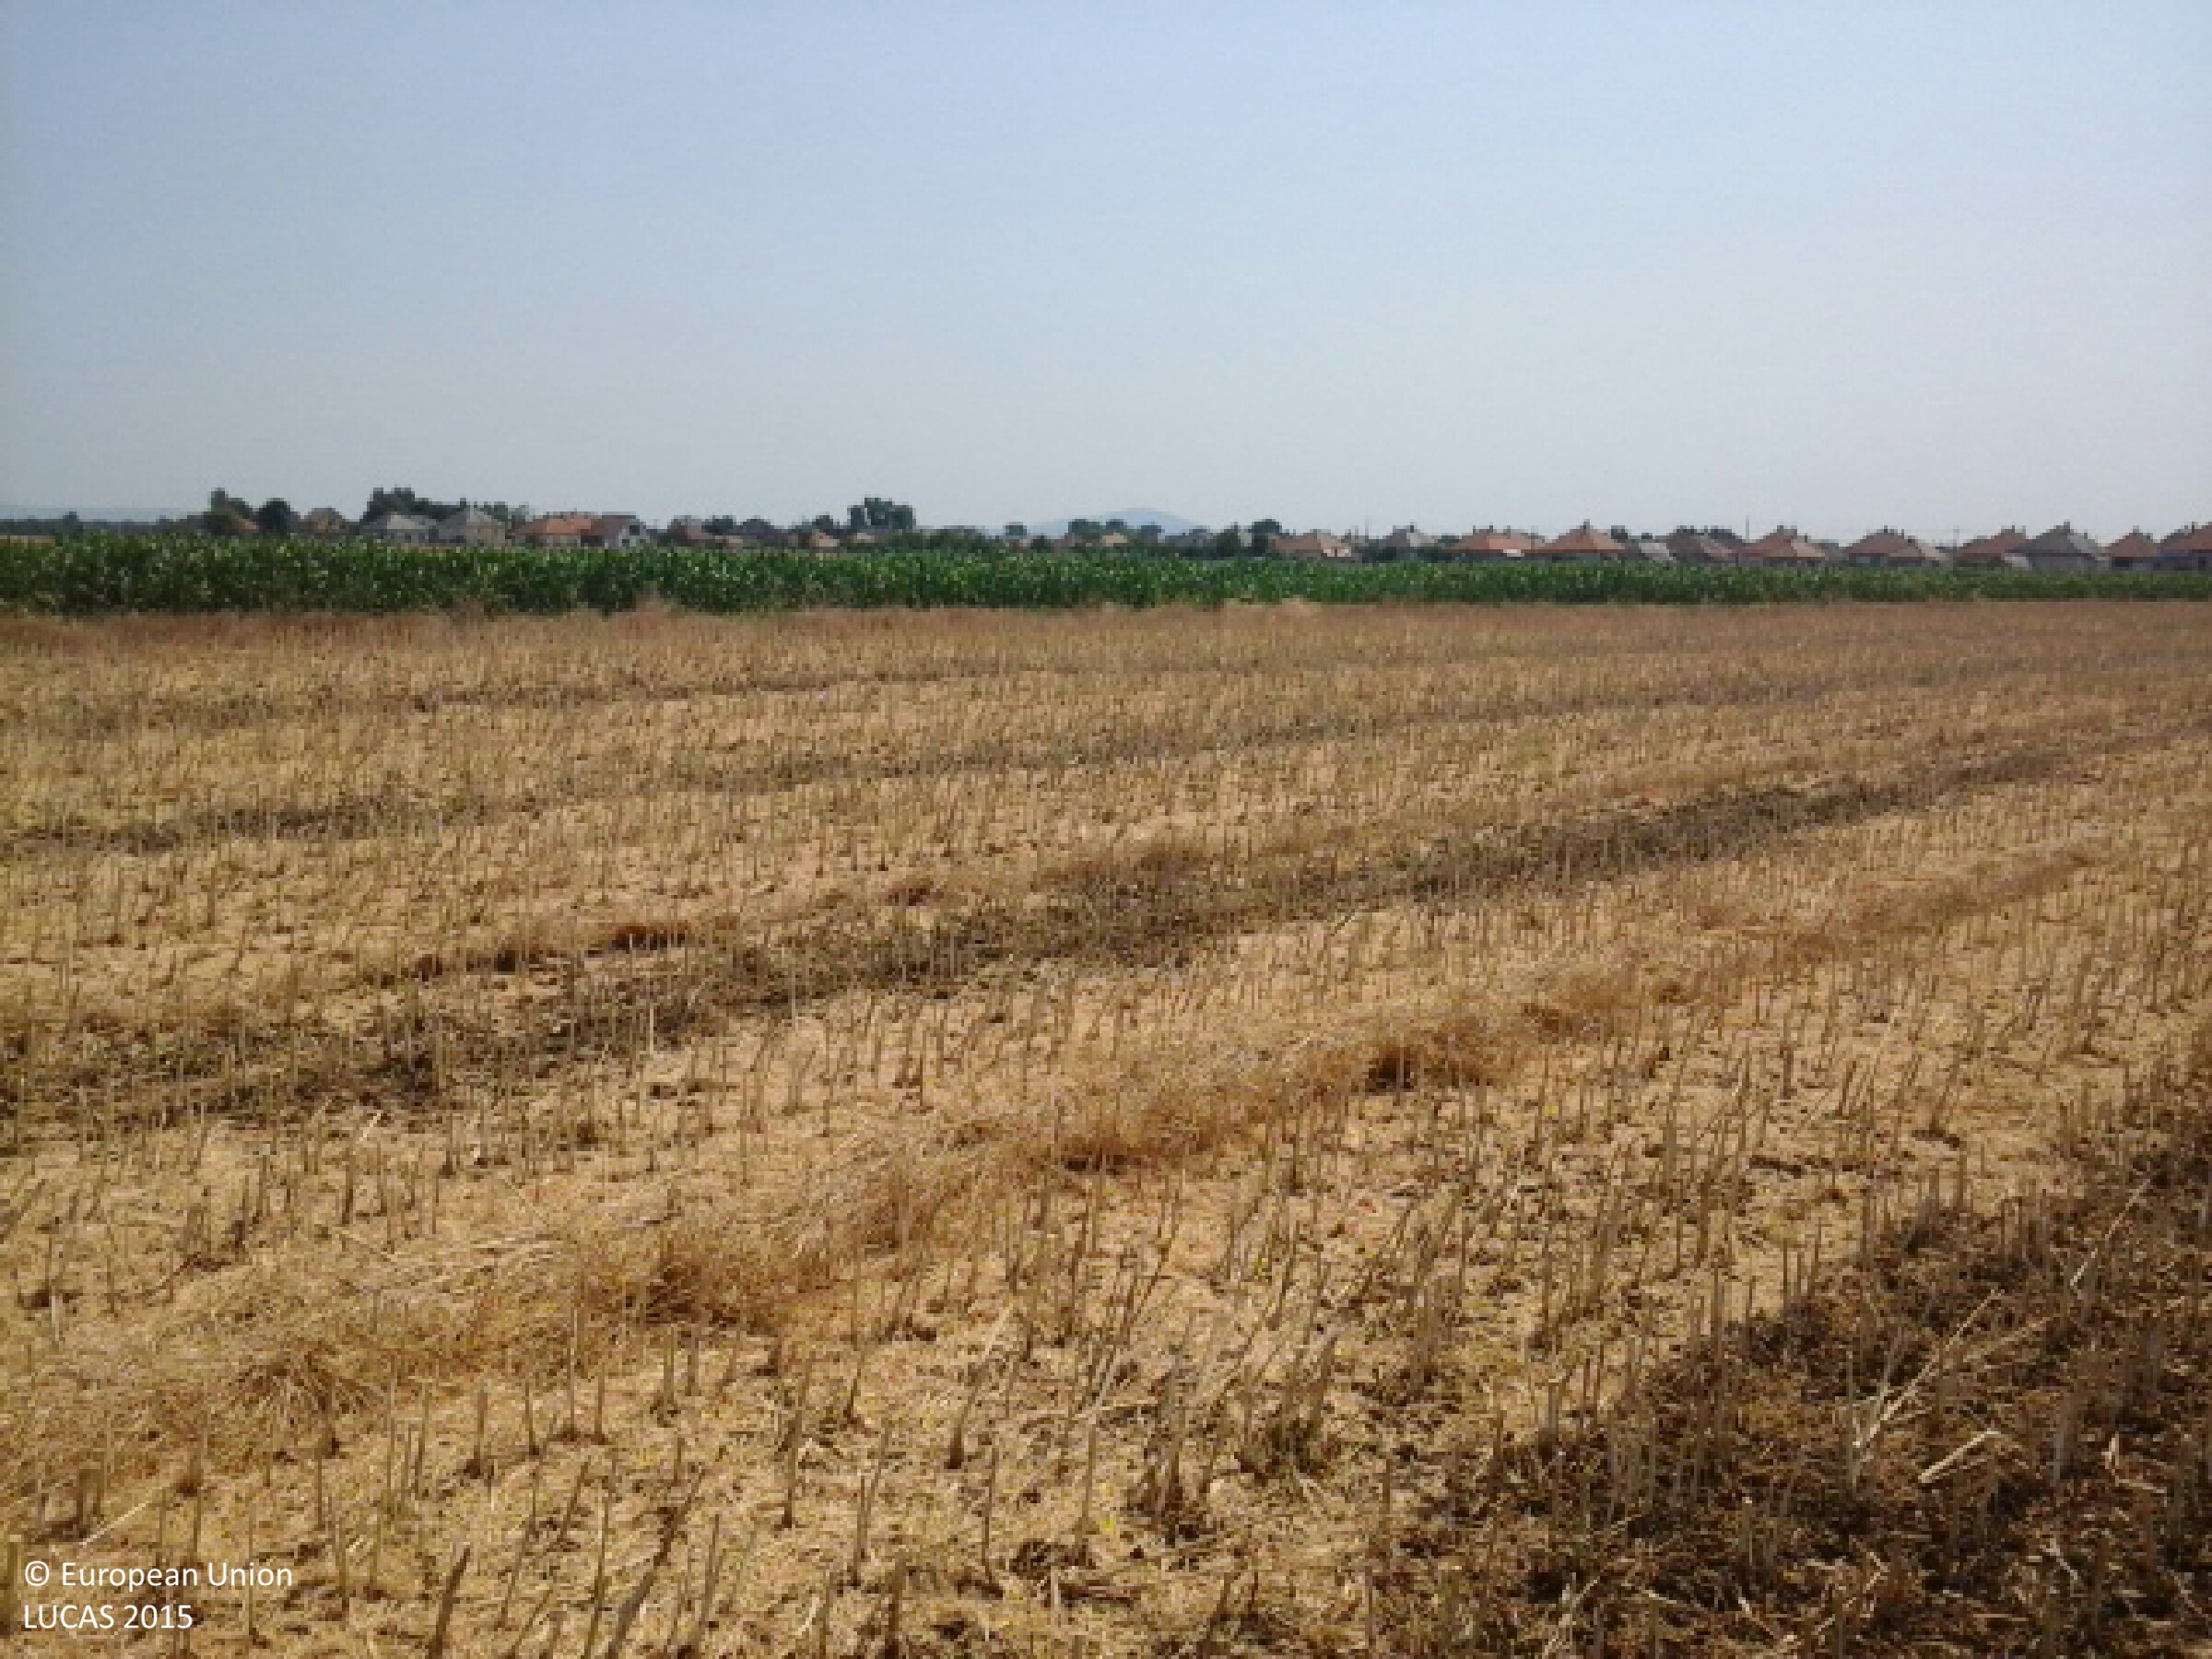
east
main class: Cropland
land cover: Rape and turnip rape
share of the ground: < 10 %
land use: Agriculture (excluding fallow land and kitchen gardens)
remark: Harvested field
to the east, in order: Rape and turnip rape; Grass margins; Paved roads, cycling and walking lanes; Grass margins; Maize
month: July
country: HU
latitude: 48.0951
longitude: 21.1181
